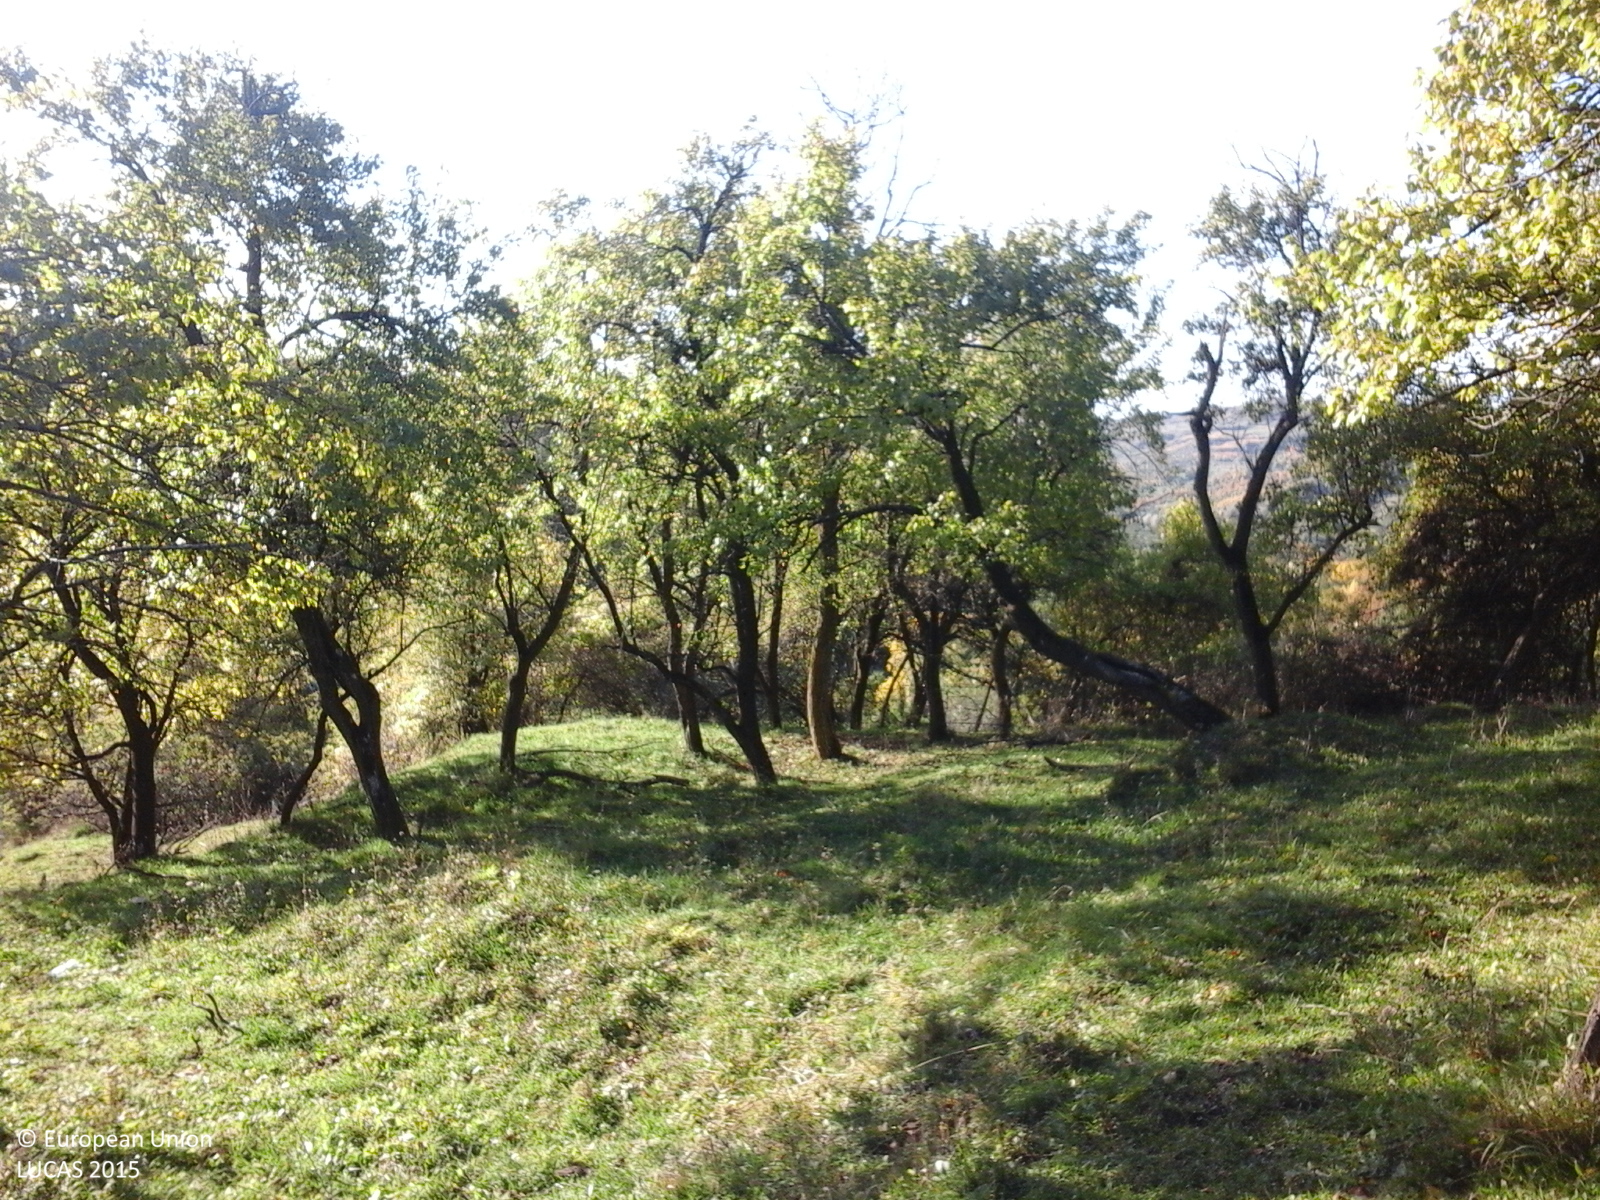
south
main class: Cropland
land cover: Other fruit trees and berries
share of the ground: > 75 %
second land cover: Grassland without tree/shrub cover
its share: > 75 %
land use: Agriculture (excluding fallow land and kitchen gardens)
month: October
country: RO
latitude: 45.2301
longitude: 25.1327
